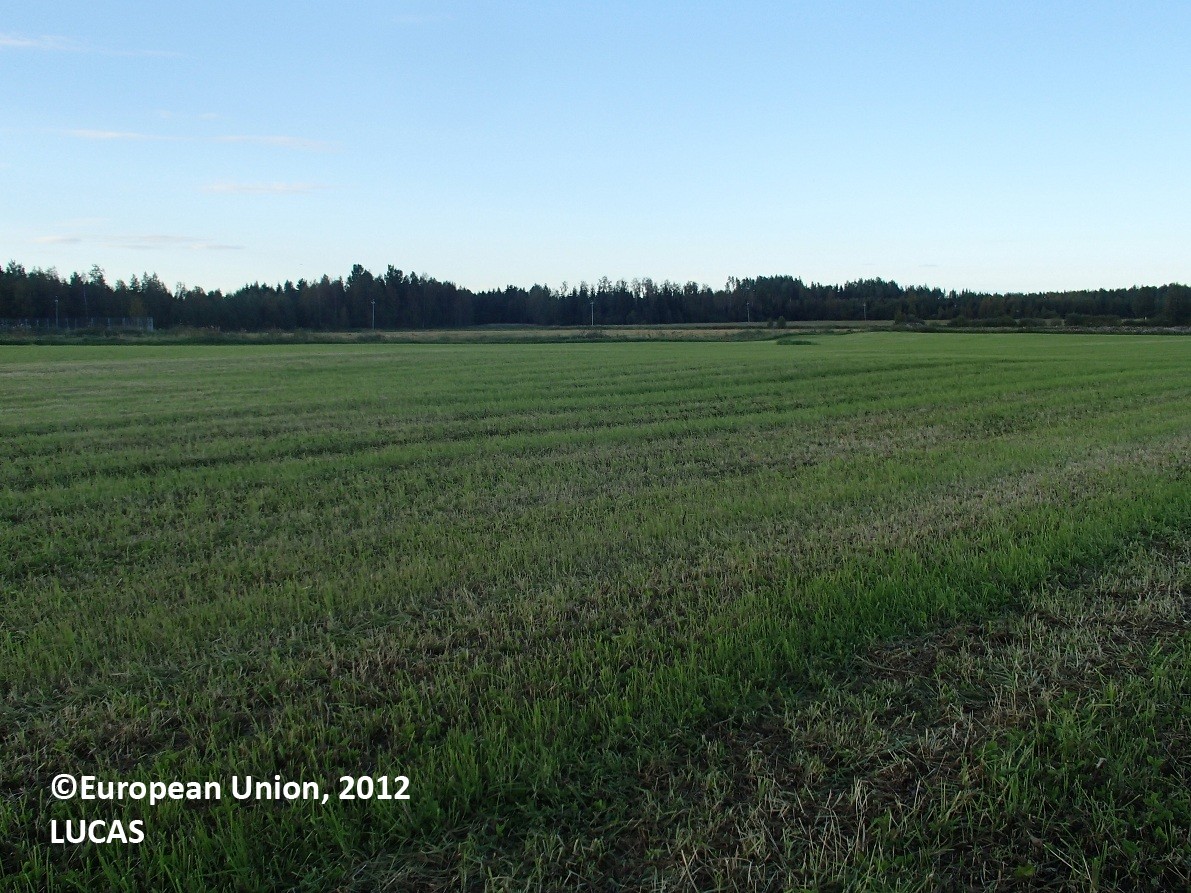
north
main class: Cropland
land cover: Temporary grasslands
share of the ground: > 75 %
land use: Agriculture (excluding fallow land and kitchen gardens)
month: August
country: FI
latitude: 63.5813
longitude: 27.0012
